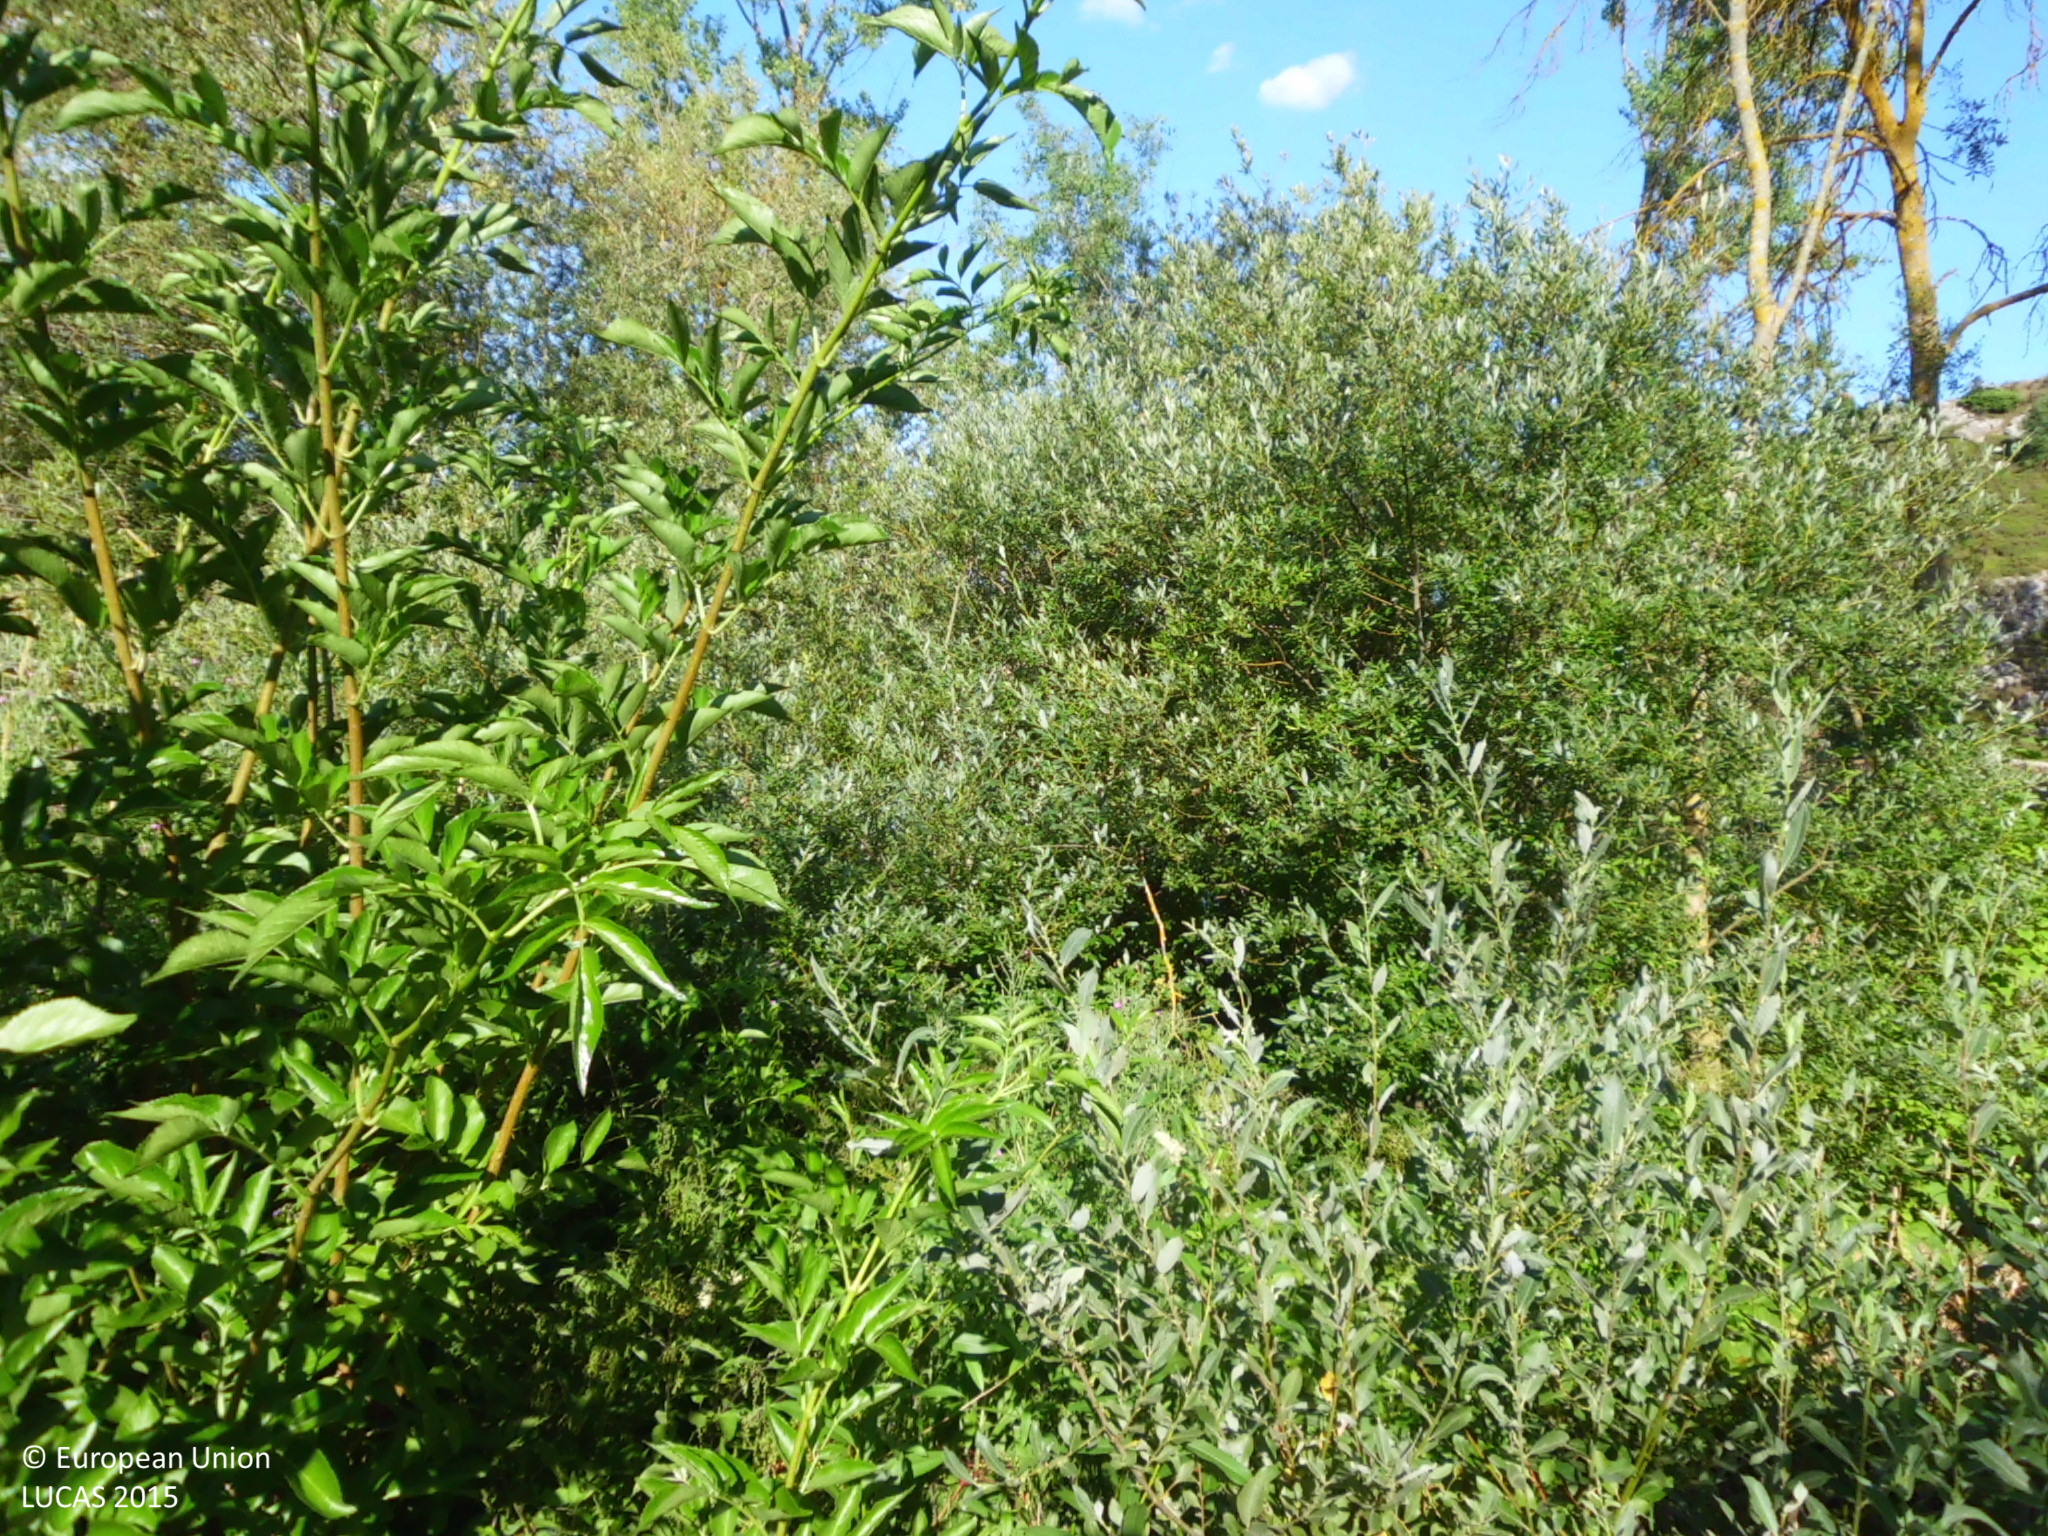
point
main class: Woodland
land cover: Broadleaved woodland
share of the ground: > 75 %
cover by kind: broadleaved forest trees 80 %, shrubs 20 %
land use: Semi-natural and natural areas not in use
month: July
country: ES
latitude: 42.8557
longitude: -4.4585
